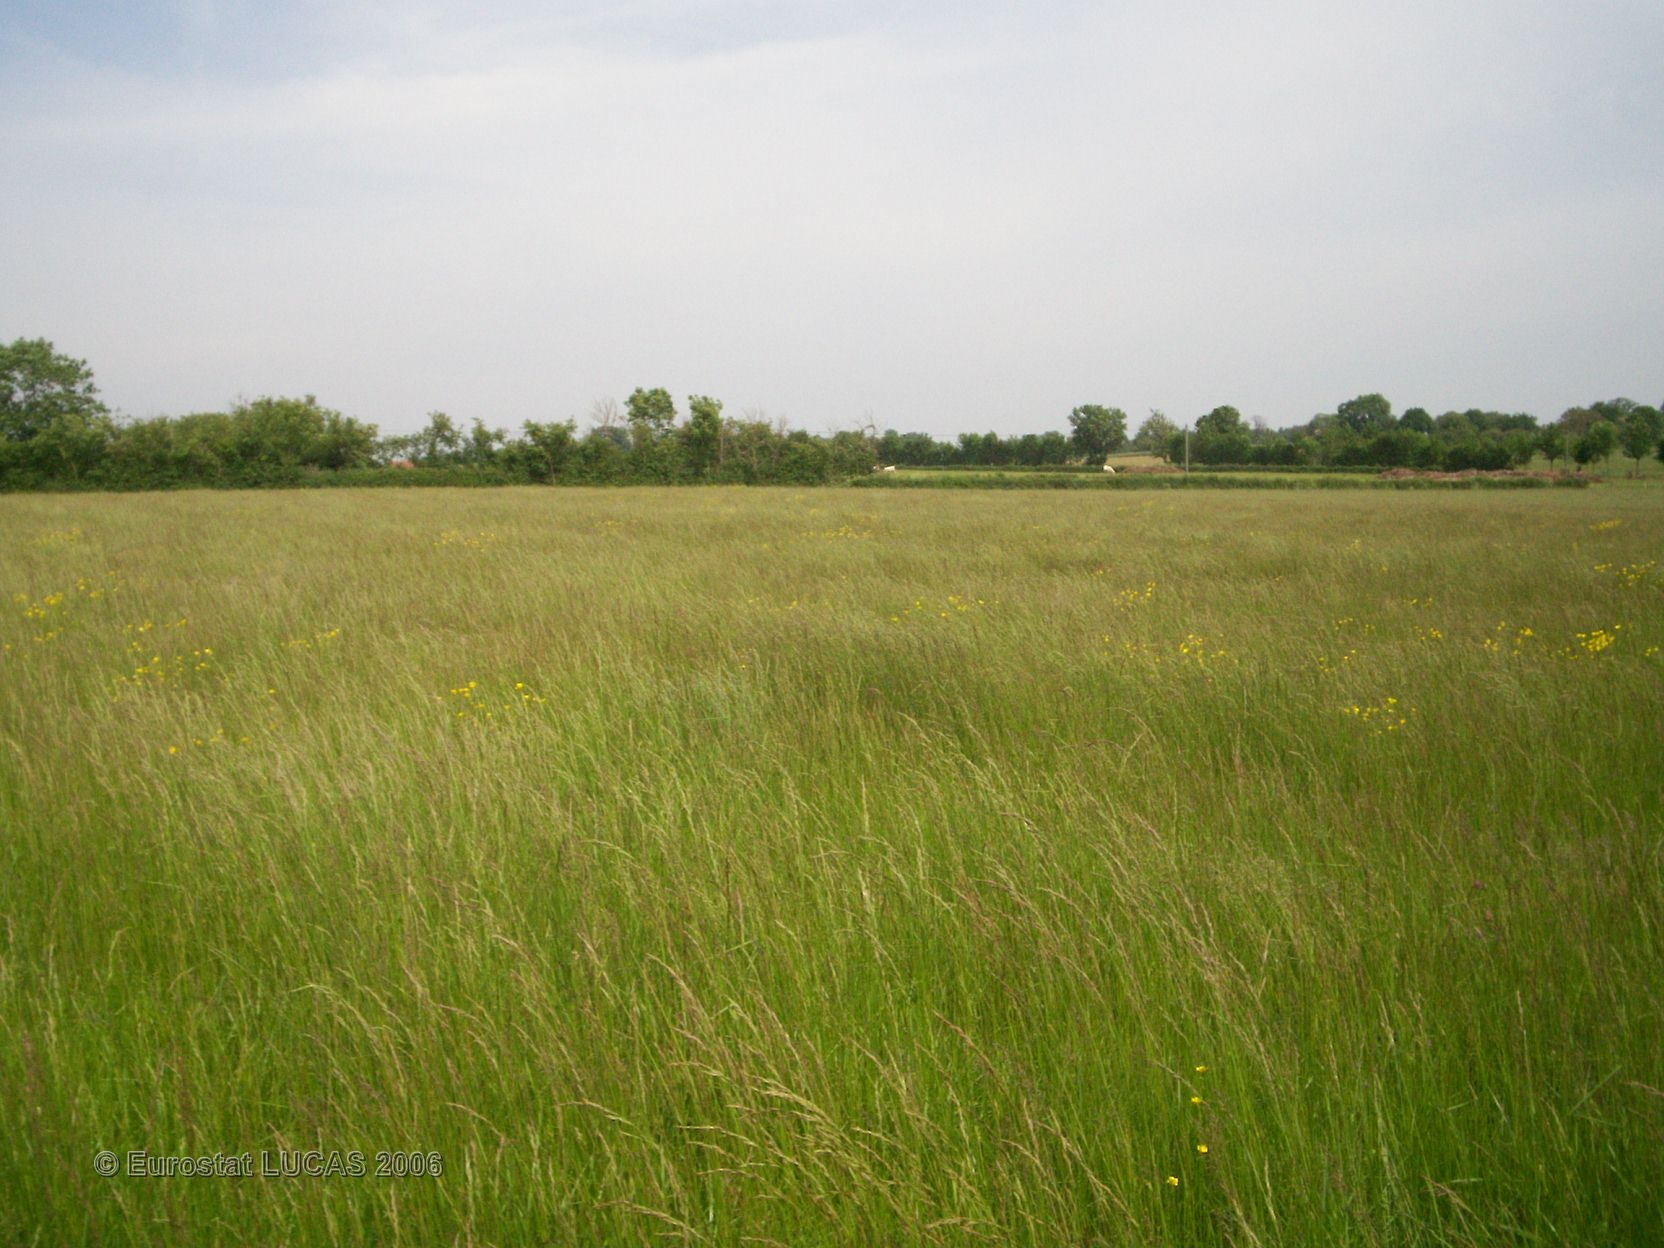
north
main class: Grassland
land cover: Grassland without tree/shrub cover
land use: Agriculture (excluding fallow land and kitchen gardens)
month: May
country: FR
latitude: 46.6019
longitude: -0.8002
